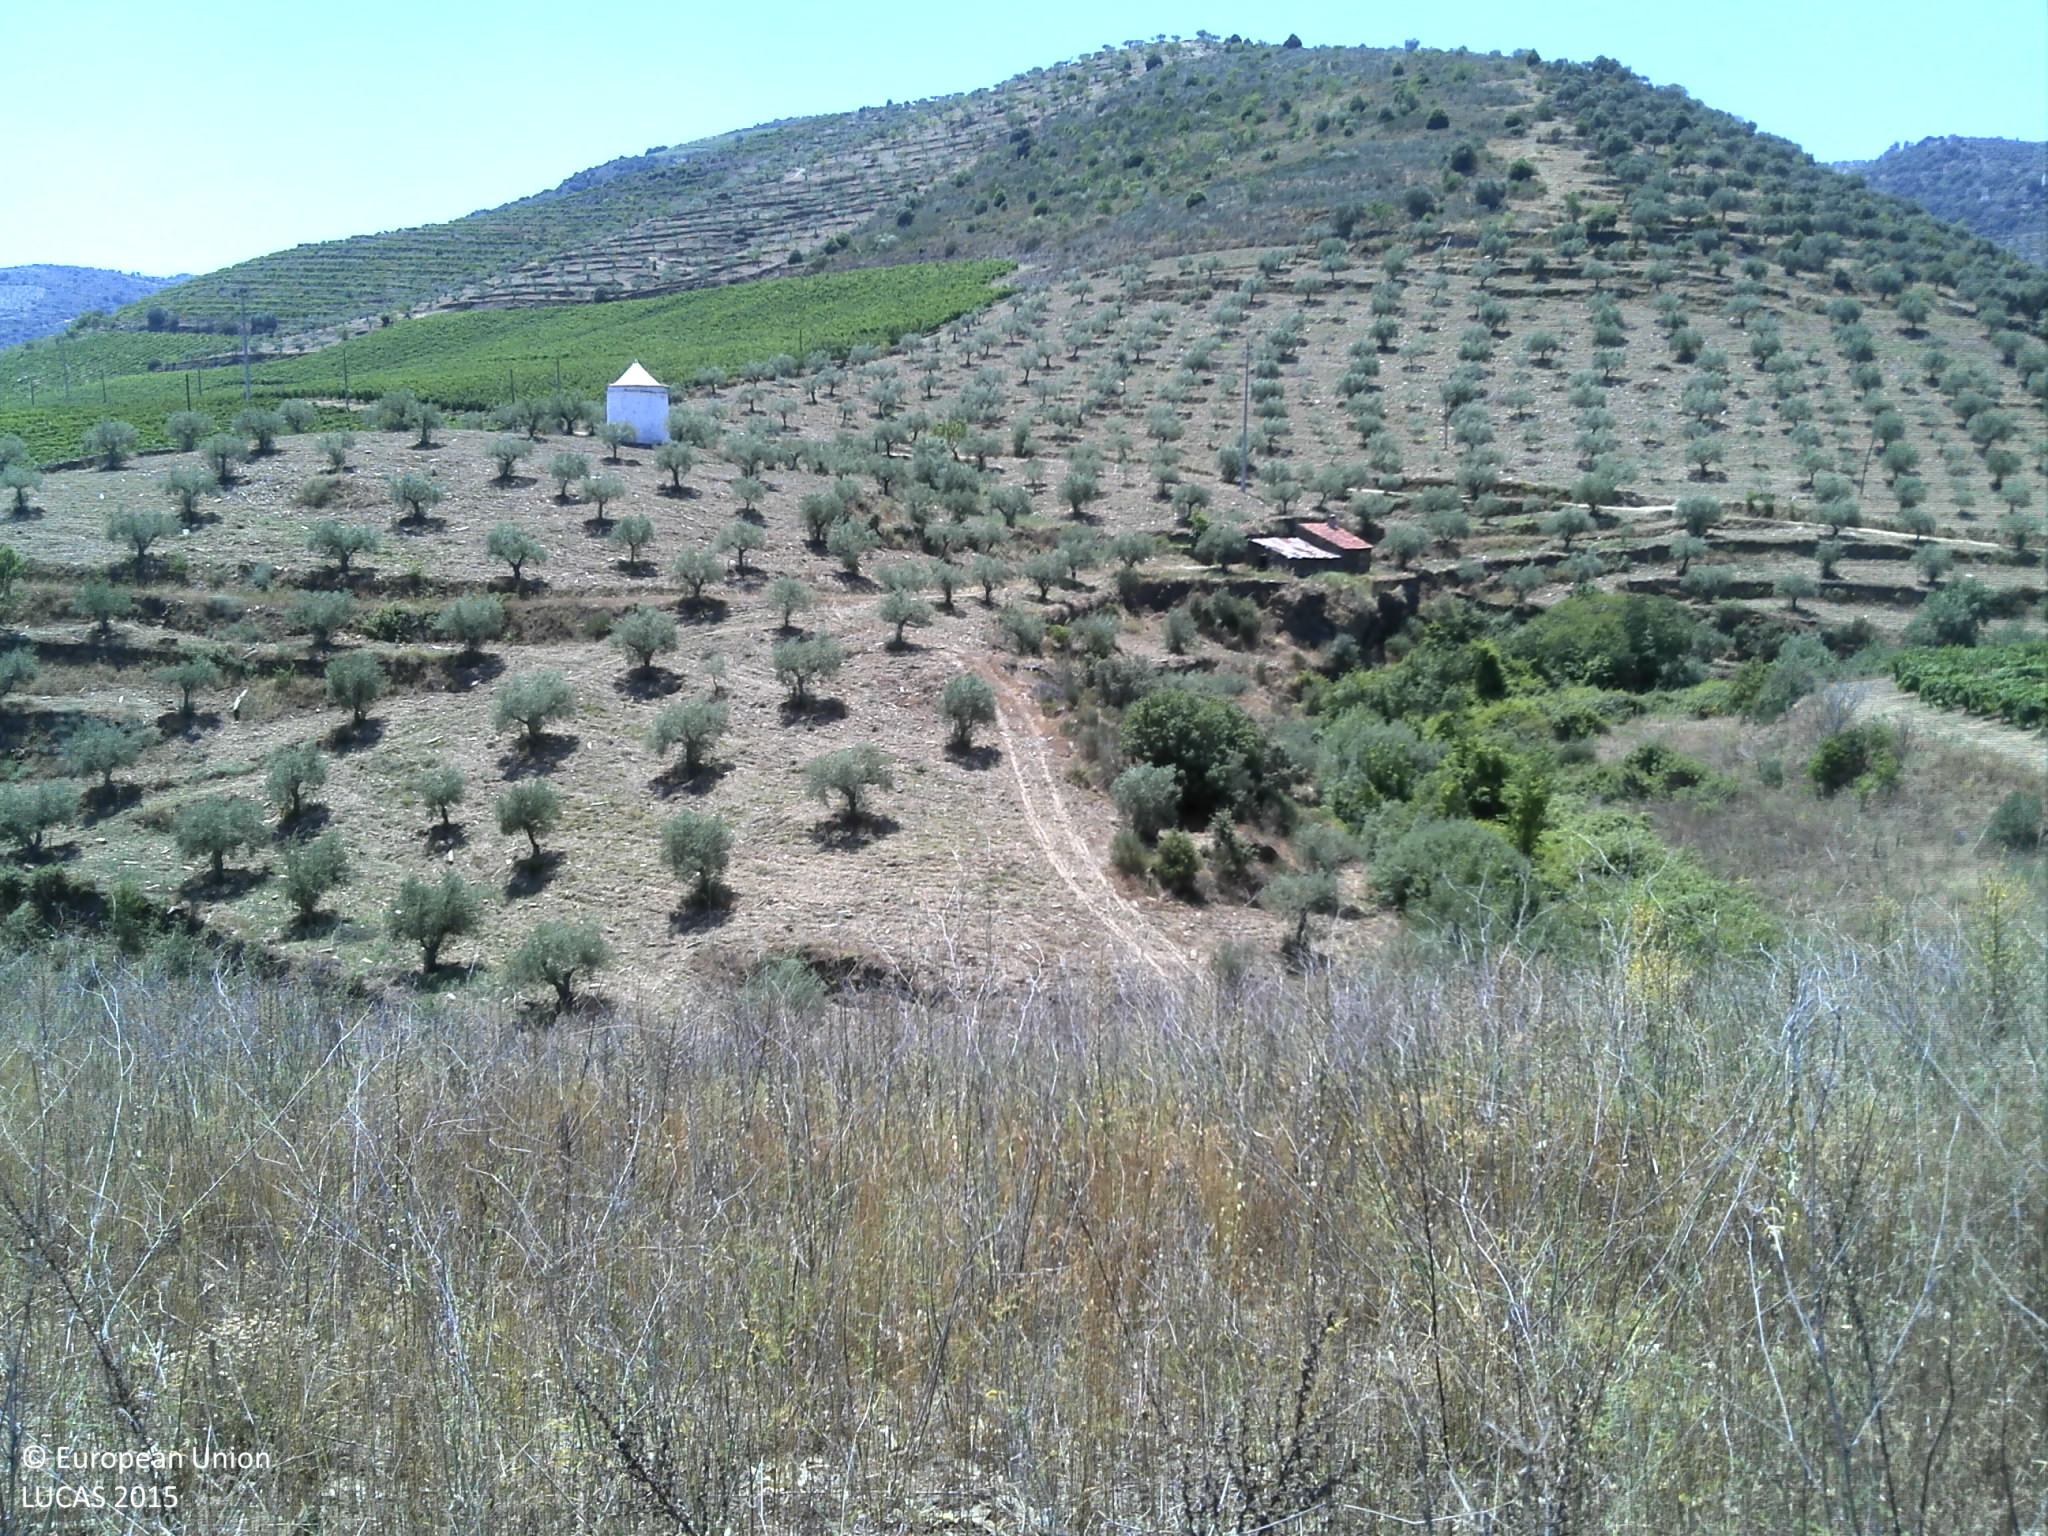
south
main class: Grassland
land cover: Spontaneously vegetated surfaces
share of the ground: > 75 %
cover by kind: herbaceous plants 95 %, unconsolidated bare surface 5 %
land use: Fallow land
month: June
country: PT
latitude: 41.0138
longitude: -6.9311
